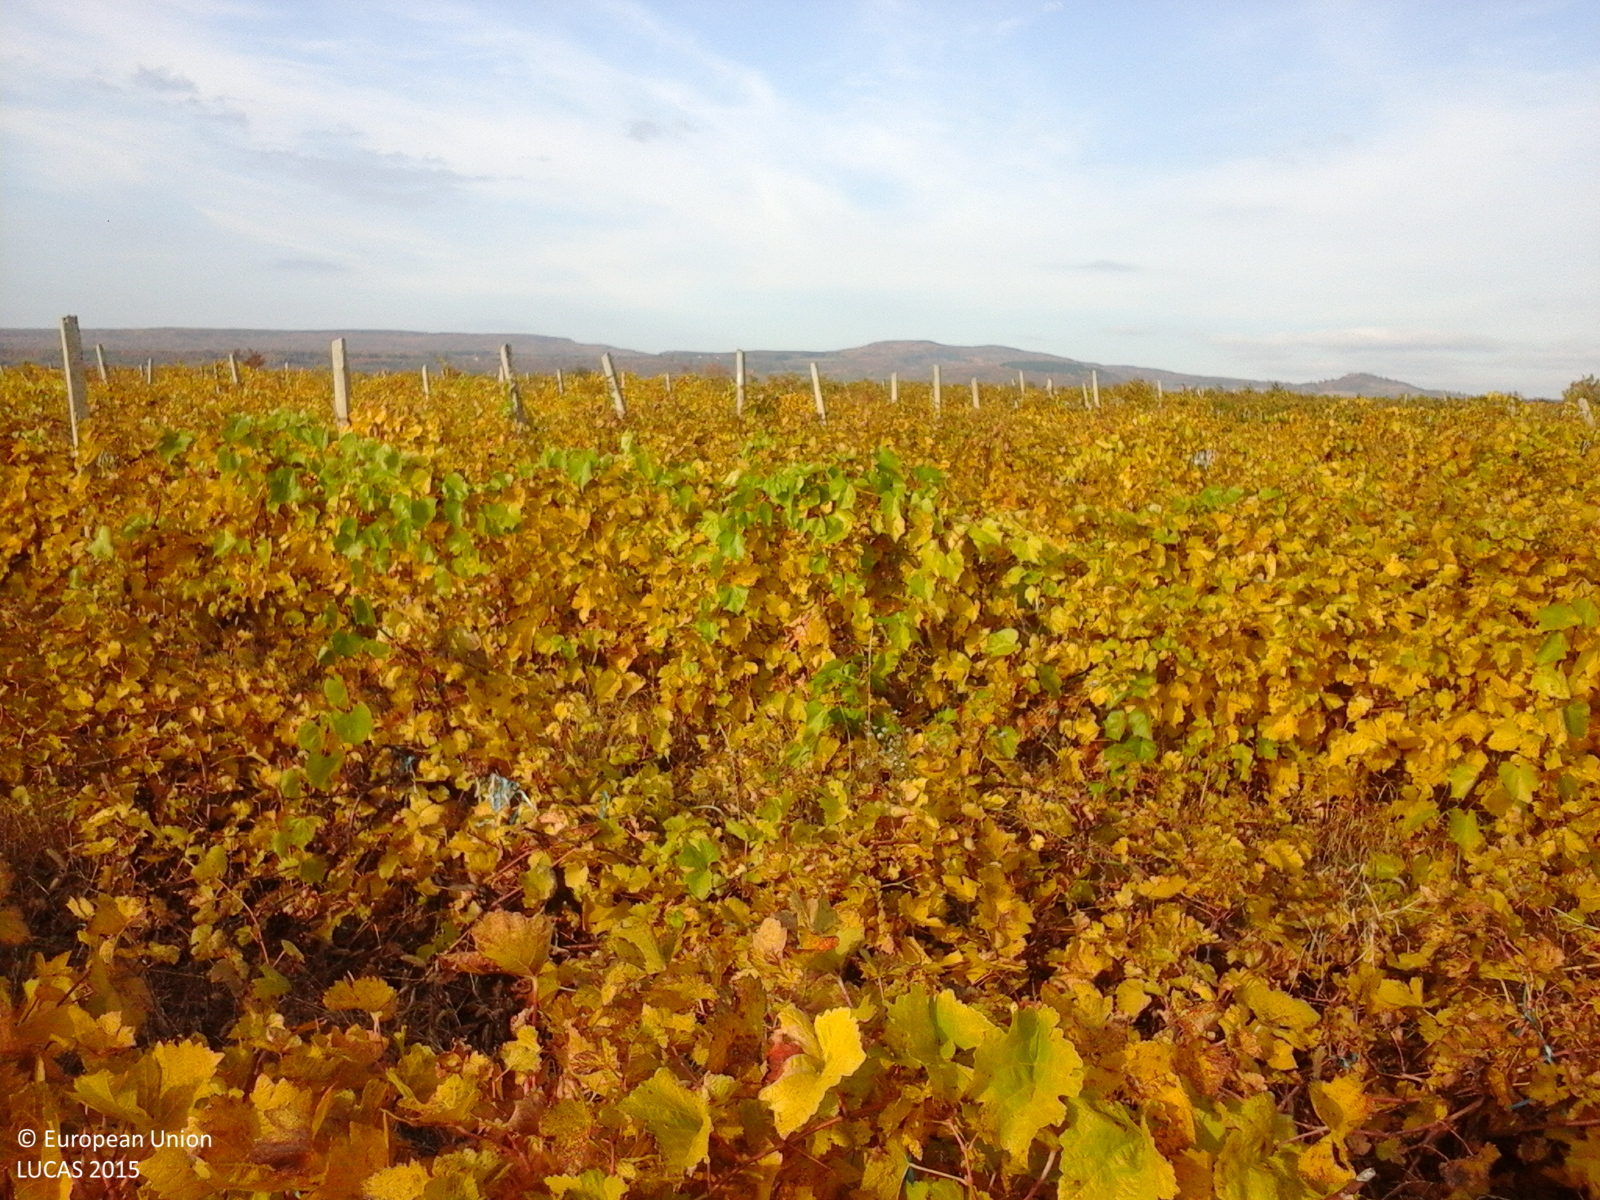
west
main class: Cropland
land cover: Vineyards
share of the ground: > 75 %
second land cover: Grassland without tree/shrub cover
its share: > 75 %
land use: Agriculture (excluding fallow land and kitchen gardens)
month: October
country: RO
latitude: 45.5166
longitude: 27.0777
